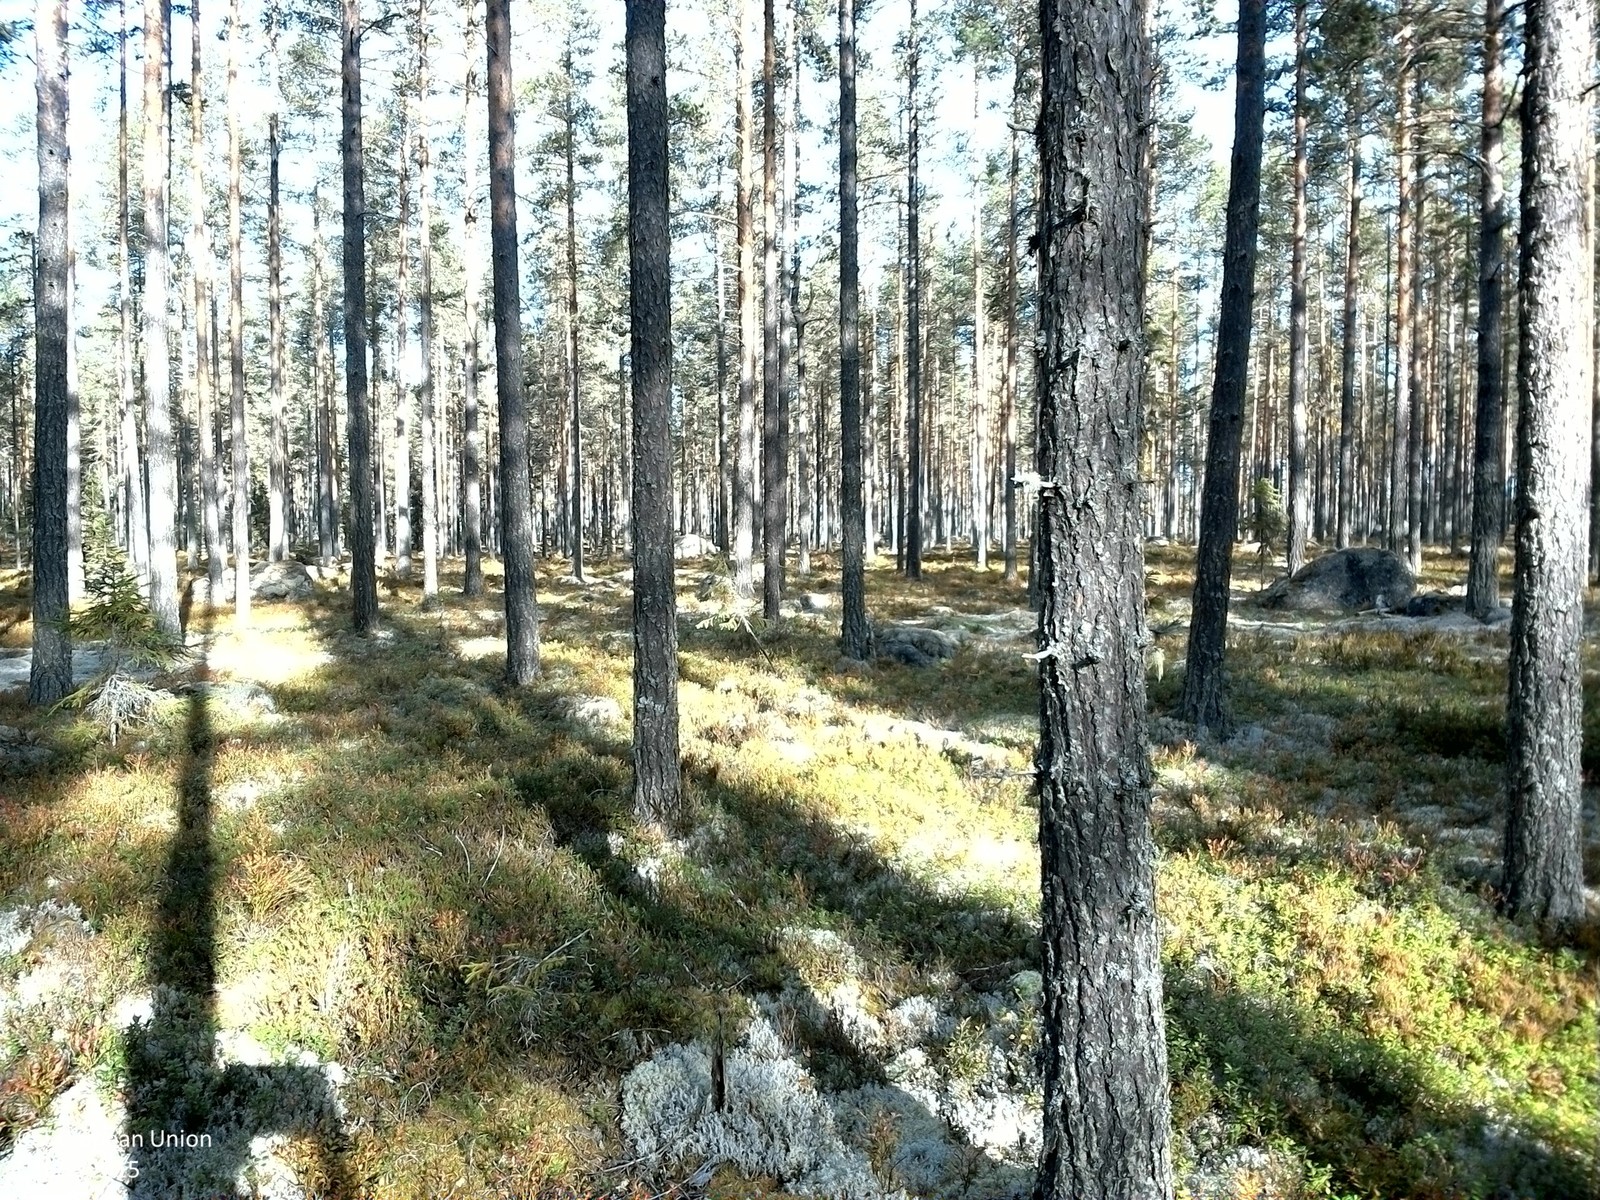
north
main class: Woodland
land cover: Pine dominated coniferous woodland
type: boreal forest
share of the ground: 50 - 75 %
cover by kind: coniferous forest trees 60 %, shrubs 30 %, lichens and mosses 5 %, consolidated bare surface 5 %
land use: Forestry
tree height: > 5 m
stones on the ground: 10 - 25 %
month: October
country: SE
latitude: 61.2253
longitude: 15.1065
